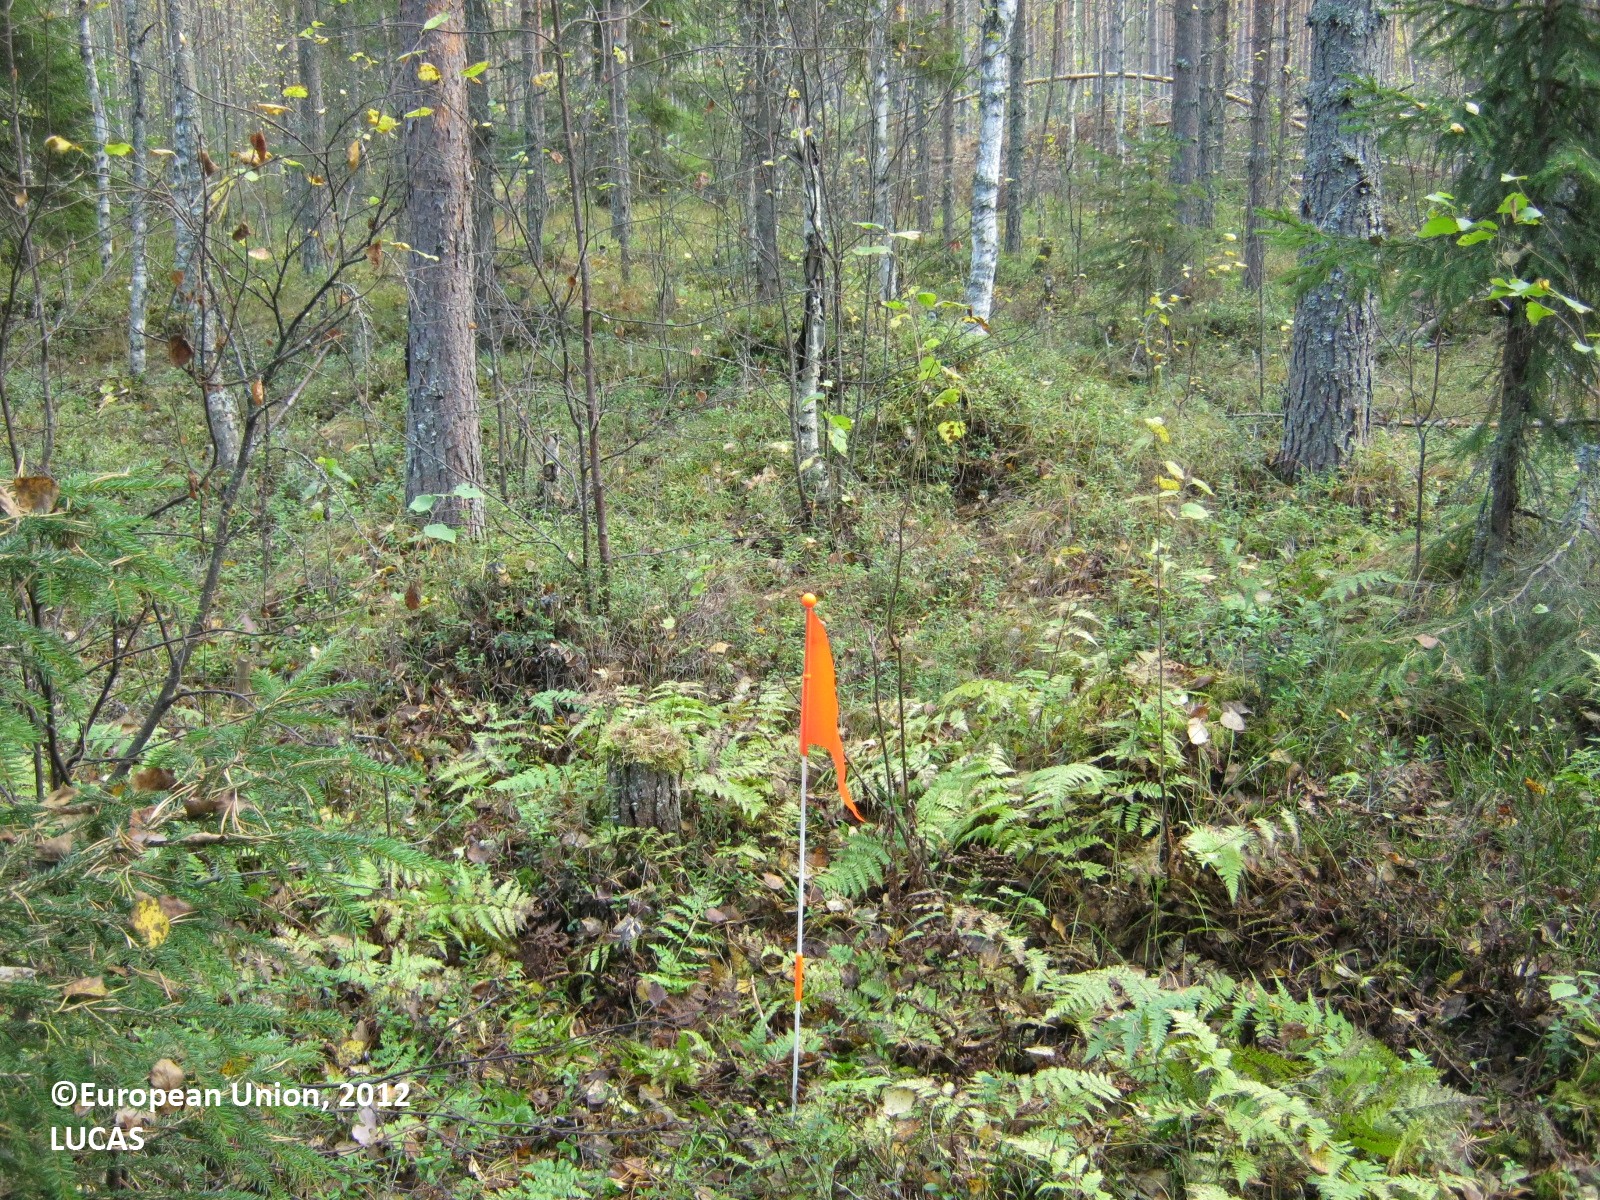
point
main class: Woodland
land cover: Pine dominated coniferous woodland
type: boreal forest
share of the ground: > 75 %
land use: Forestry
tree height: > 5 m
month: September
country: FI
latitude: 63.3545
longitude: 25.8404
